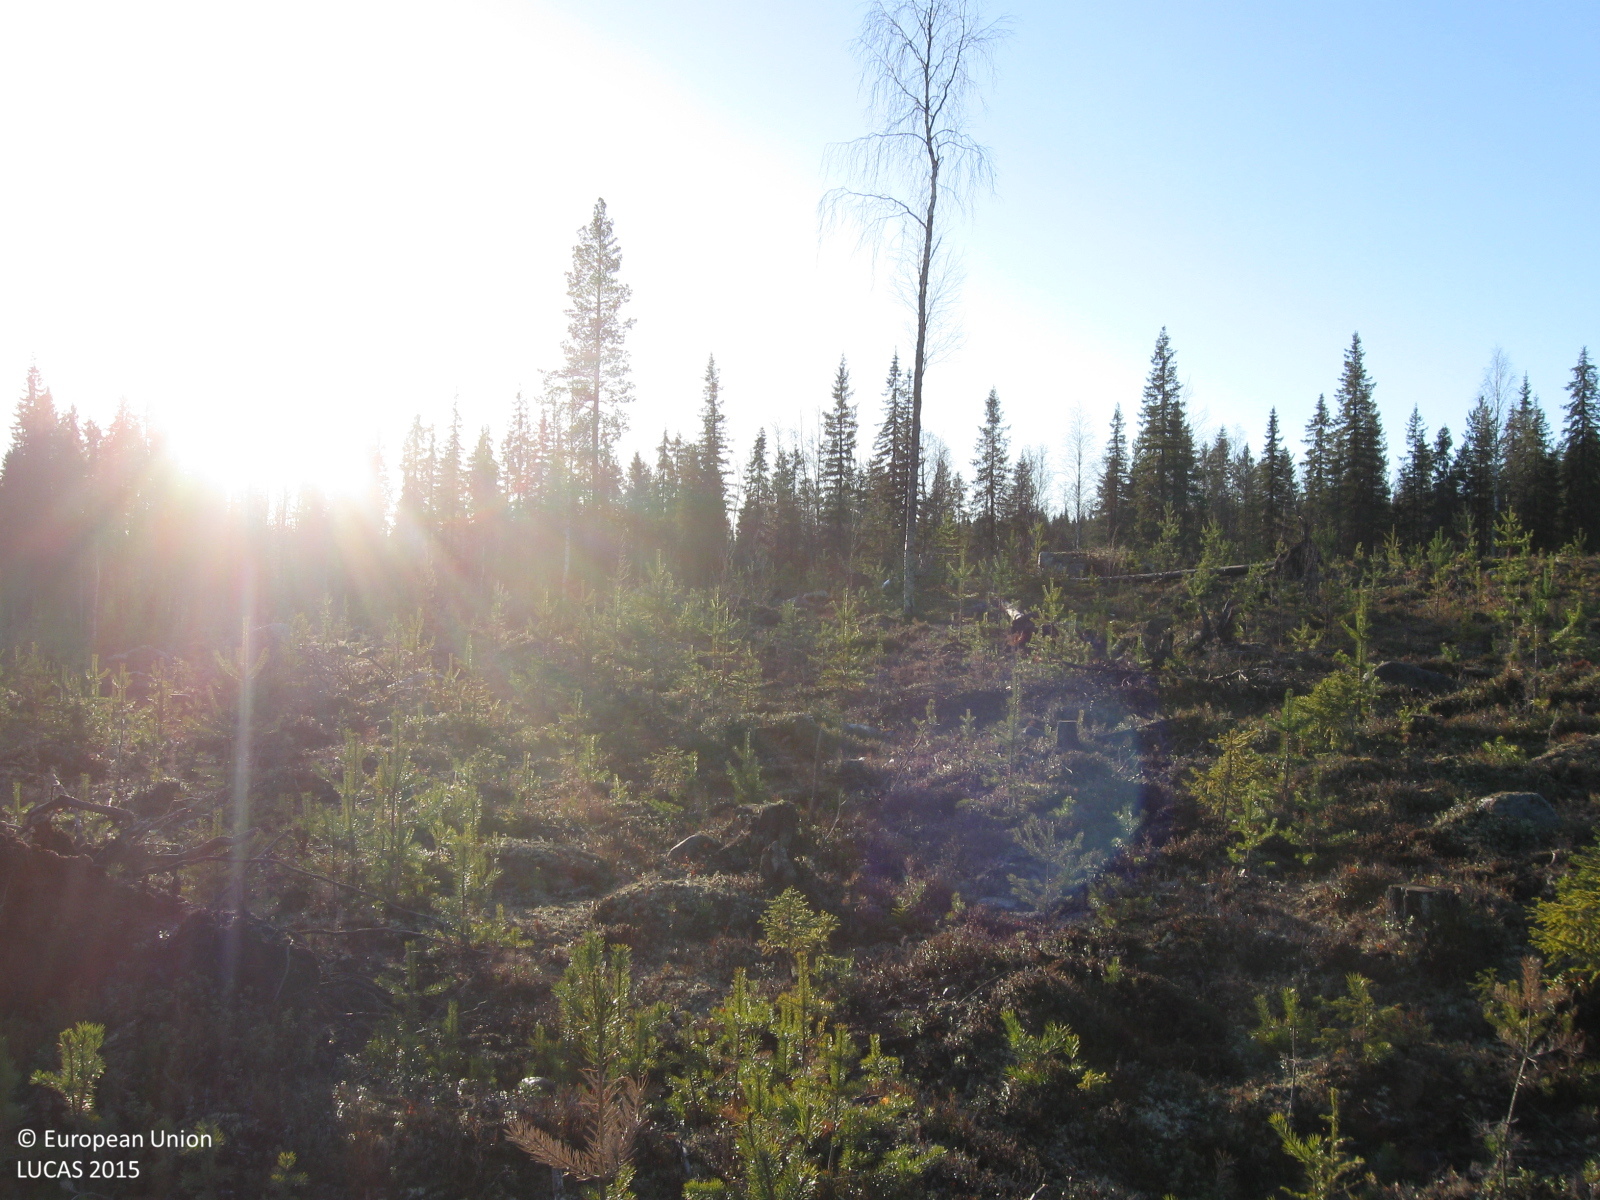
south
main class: Woodland
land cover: Pine dominated coniferous woodland
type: boreal forest
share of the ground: 25 - 50 %
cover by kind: coniferous forest trees 30 %, shrubs 20 %, herbaceous plants 10 %, lichens and mosses 10 %, consolidated bare surface 10 %, unconsolidated bare surface 10 %, broadleaved forest trees 5 %
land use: Forestry
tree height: < 5 m
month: November
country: SE
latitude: 66.1134
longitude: 20.7845
